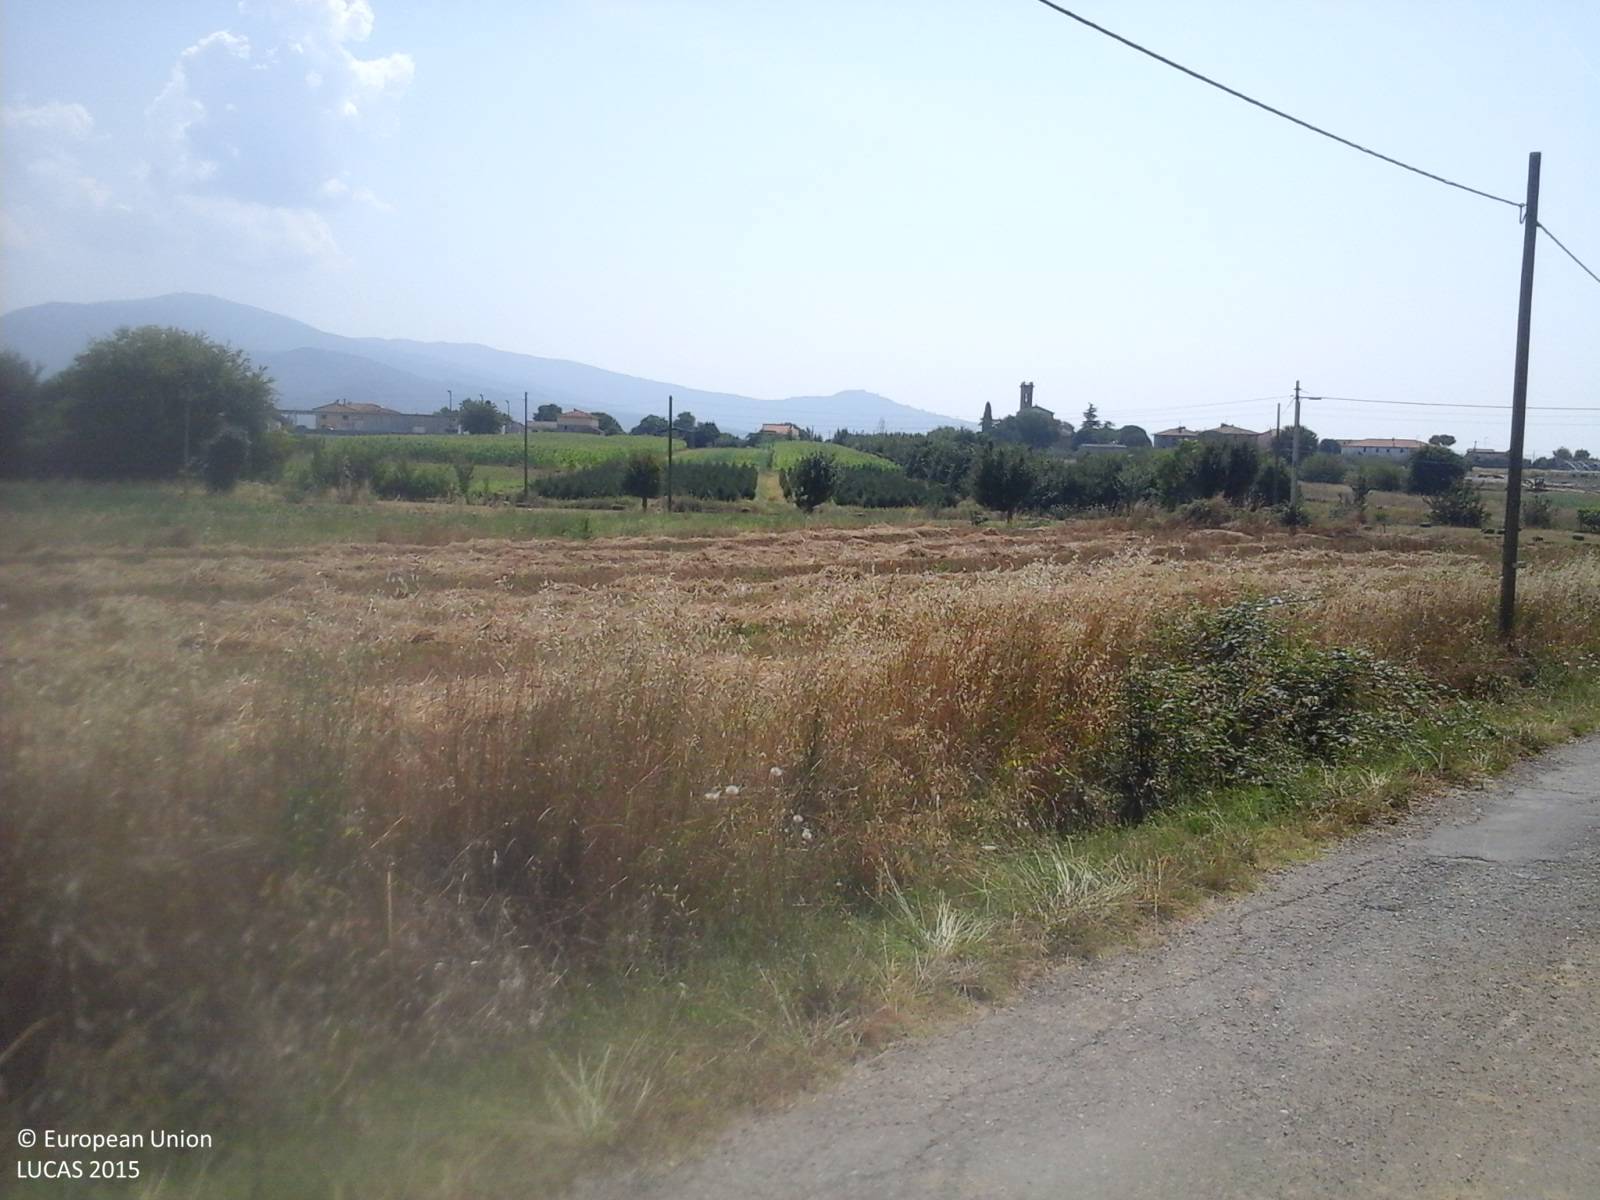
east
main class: Shrubland
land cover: Shrubland with sparse tree cover
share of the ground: 50 - 75 %
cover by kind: shrubs 95 %, broadleaved forest trees 5 %
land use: Abandoned areas
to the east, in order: Shrubland with sparse tree cover; Paved roads, cycling and walking lanes; Ditches and canals; Electric lines; Durum wheat; Lucerne; Electric lines; Ditches and canals; Grass margins; Paved roads, cycling and walking lanes; Grass margins; Lucerne; Ditches and canals; Abandoned hedges; Maize; Ditches and canals; Vineyards; Grass margins; Ditches and canals; Grassland without tree/shrub cover
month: July
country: IT
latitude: 43.3048
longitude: 11.8808
